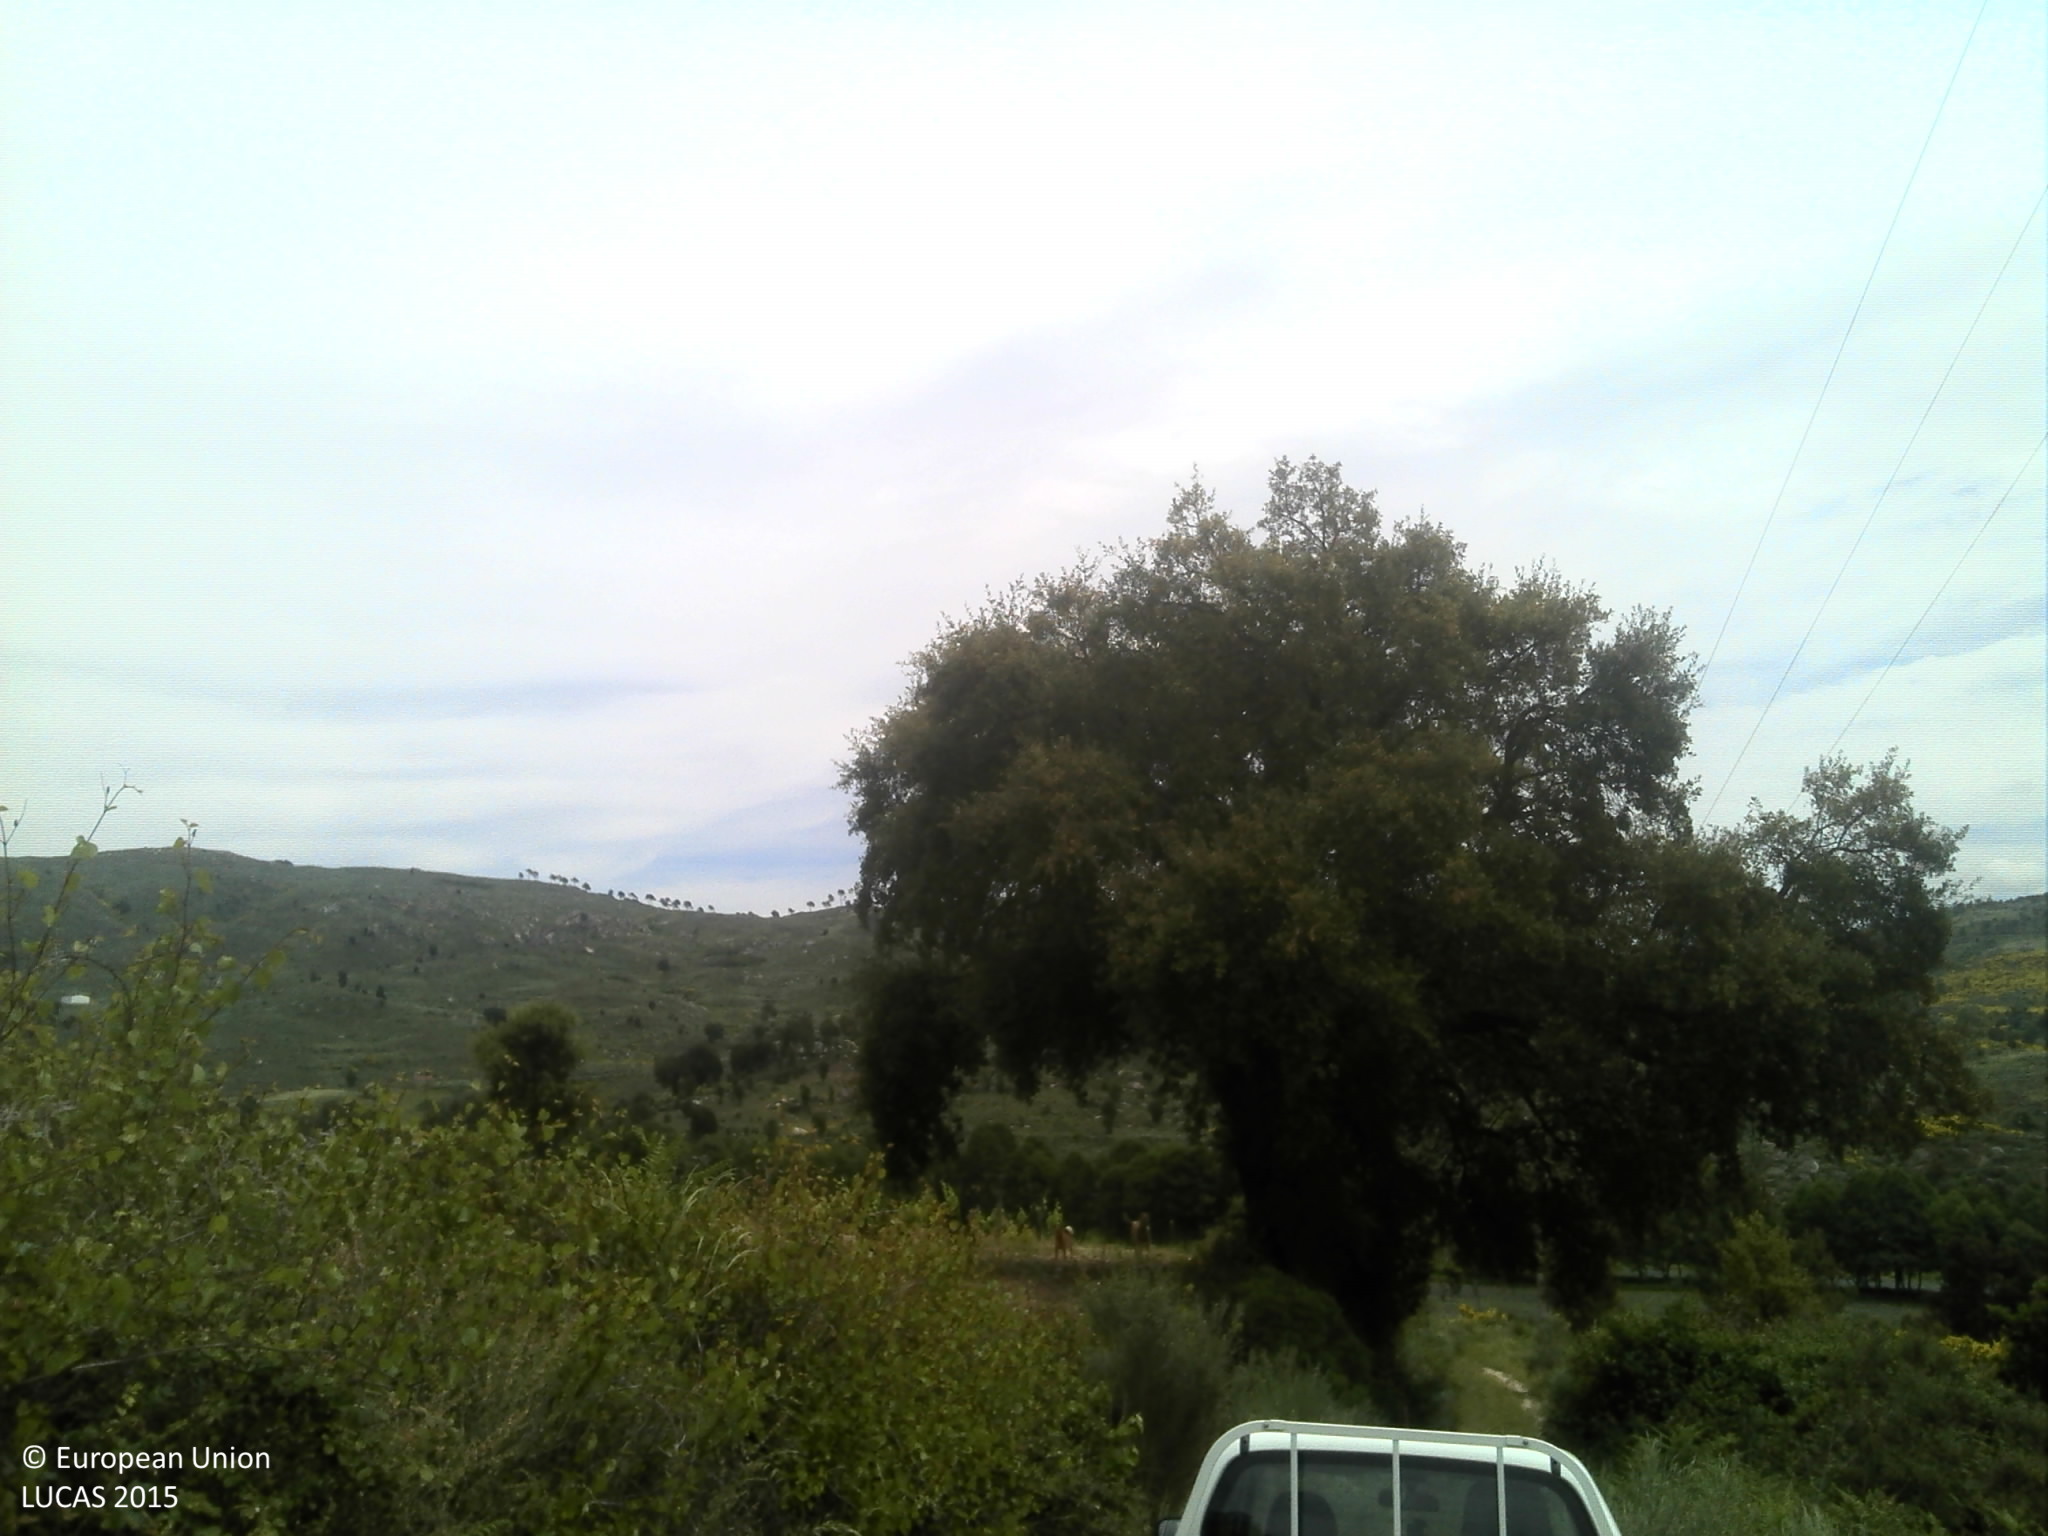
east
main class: Shrubland
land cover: Shrubland with sparse tree cover
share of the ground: > 75 %
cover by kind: shrubs 90 %, coniferous forest trees 5 %, unconsolidated bare surface 5 %
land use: Semi-natural and natural areas not in use
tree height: < 5 m
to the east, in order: Shrubland with sparse tree cover; Electric lines; Shrubland with sparse tree cover; Tracks; Vineyards; Tracks; Spontaneously vegetated surfaces
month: May
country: PT
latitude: 40.7009
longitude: -7.4516
